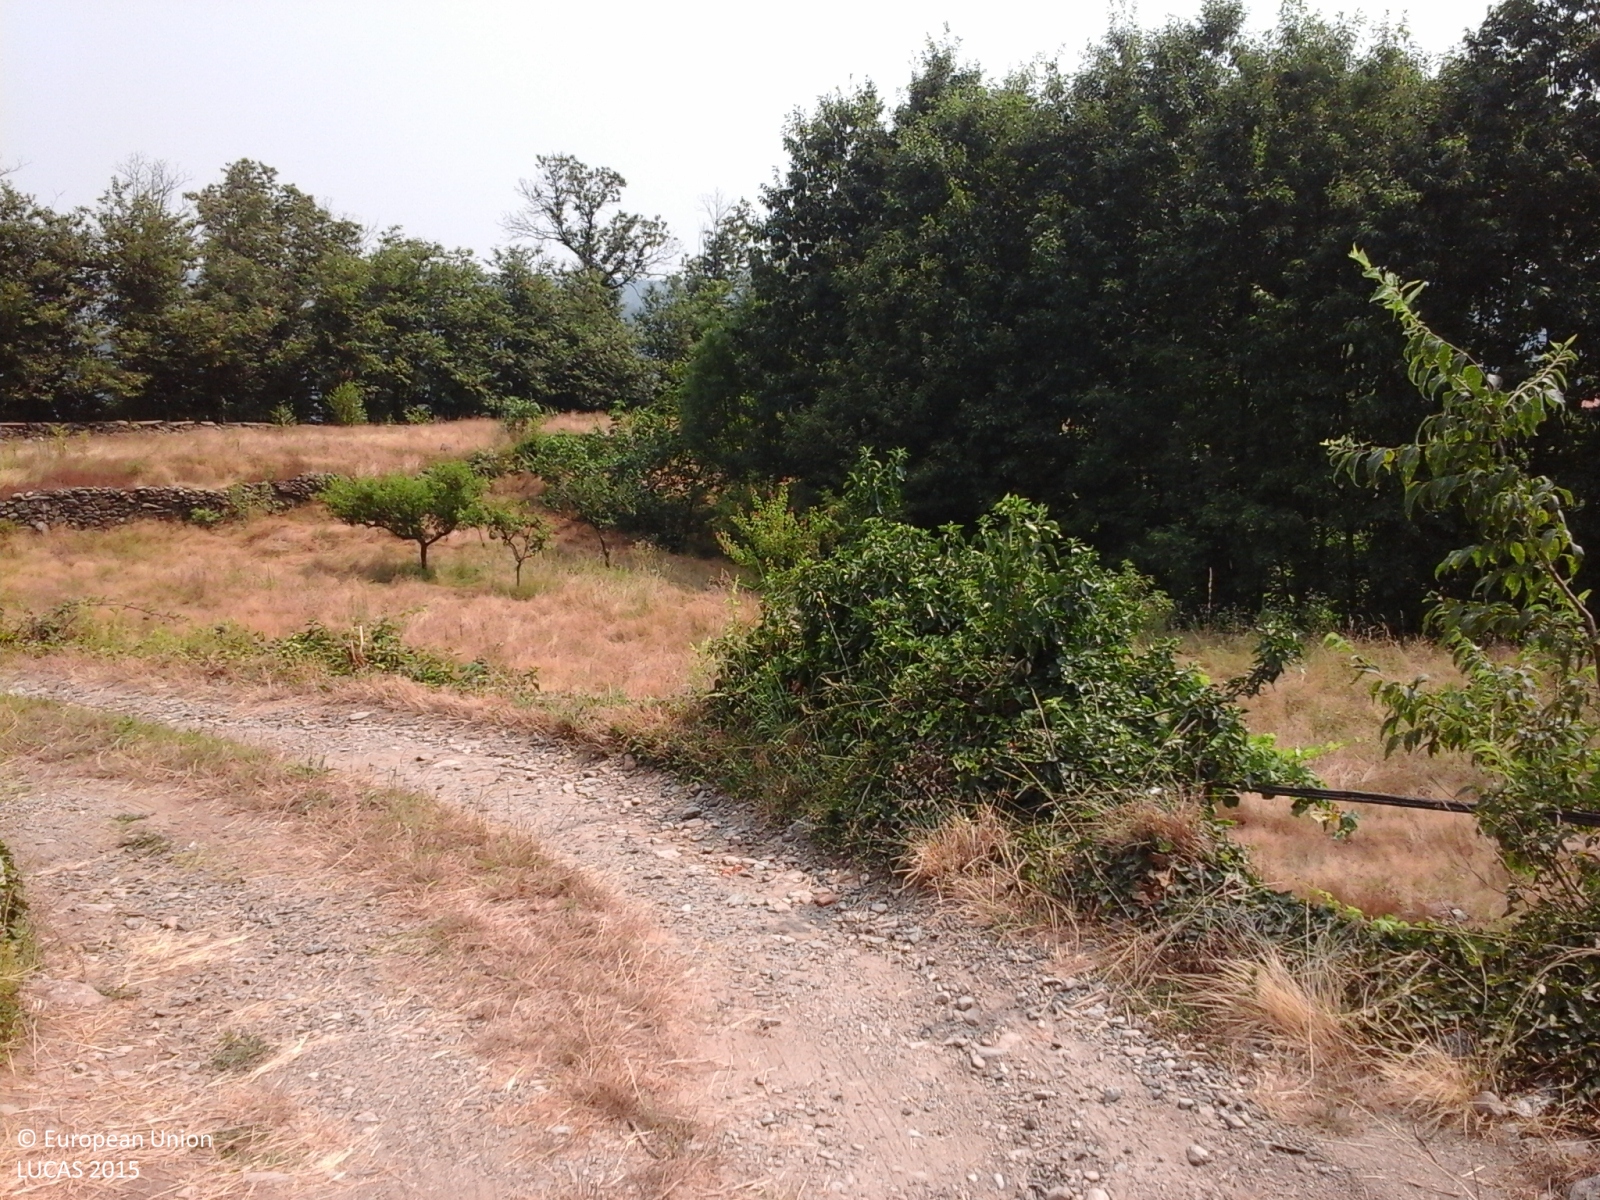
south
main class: Woodland
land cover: Broadleaved woodland
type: thermophilous deciduous forest
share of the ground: > 75 %
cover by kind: broadleaved forest trees 100 %
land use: Semi-natural and natural areas not in use
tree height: > 5 m
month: July
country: IT
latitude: 45.4267
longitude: 7.7669
